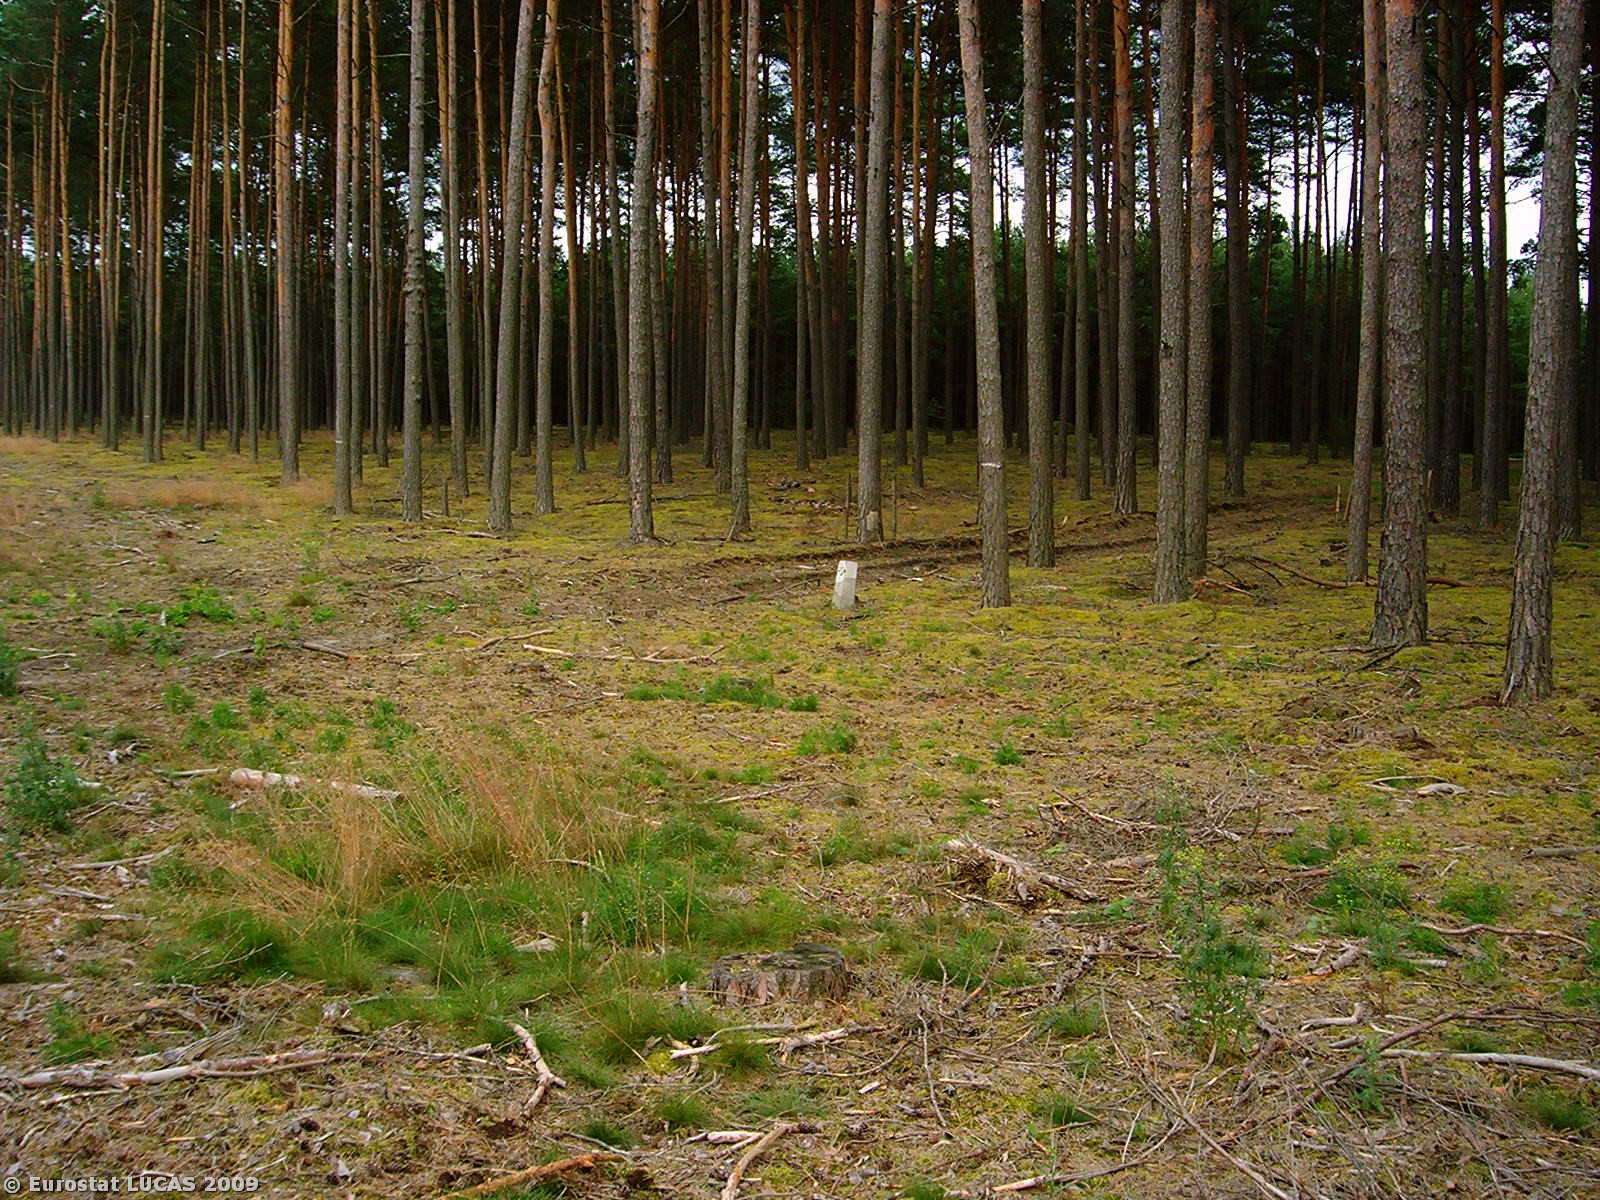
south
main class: Grassland
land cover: Spontaneously vegetated surfaces
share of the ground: 25 - 50 %
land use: Forestry
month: July
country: PL
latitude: 52.6152
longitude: 15.3944
